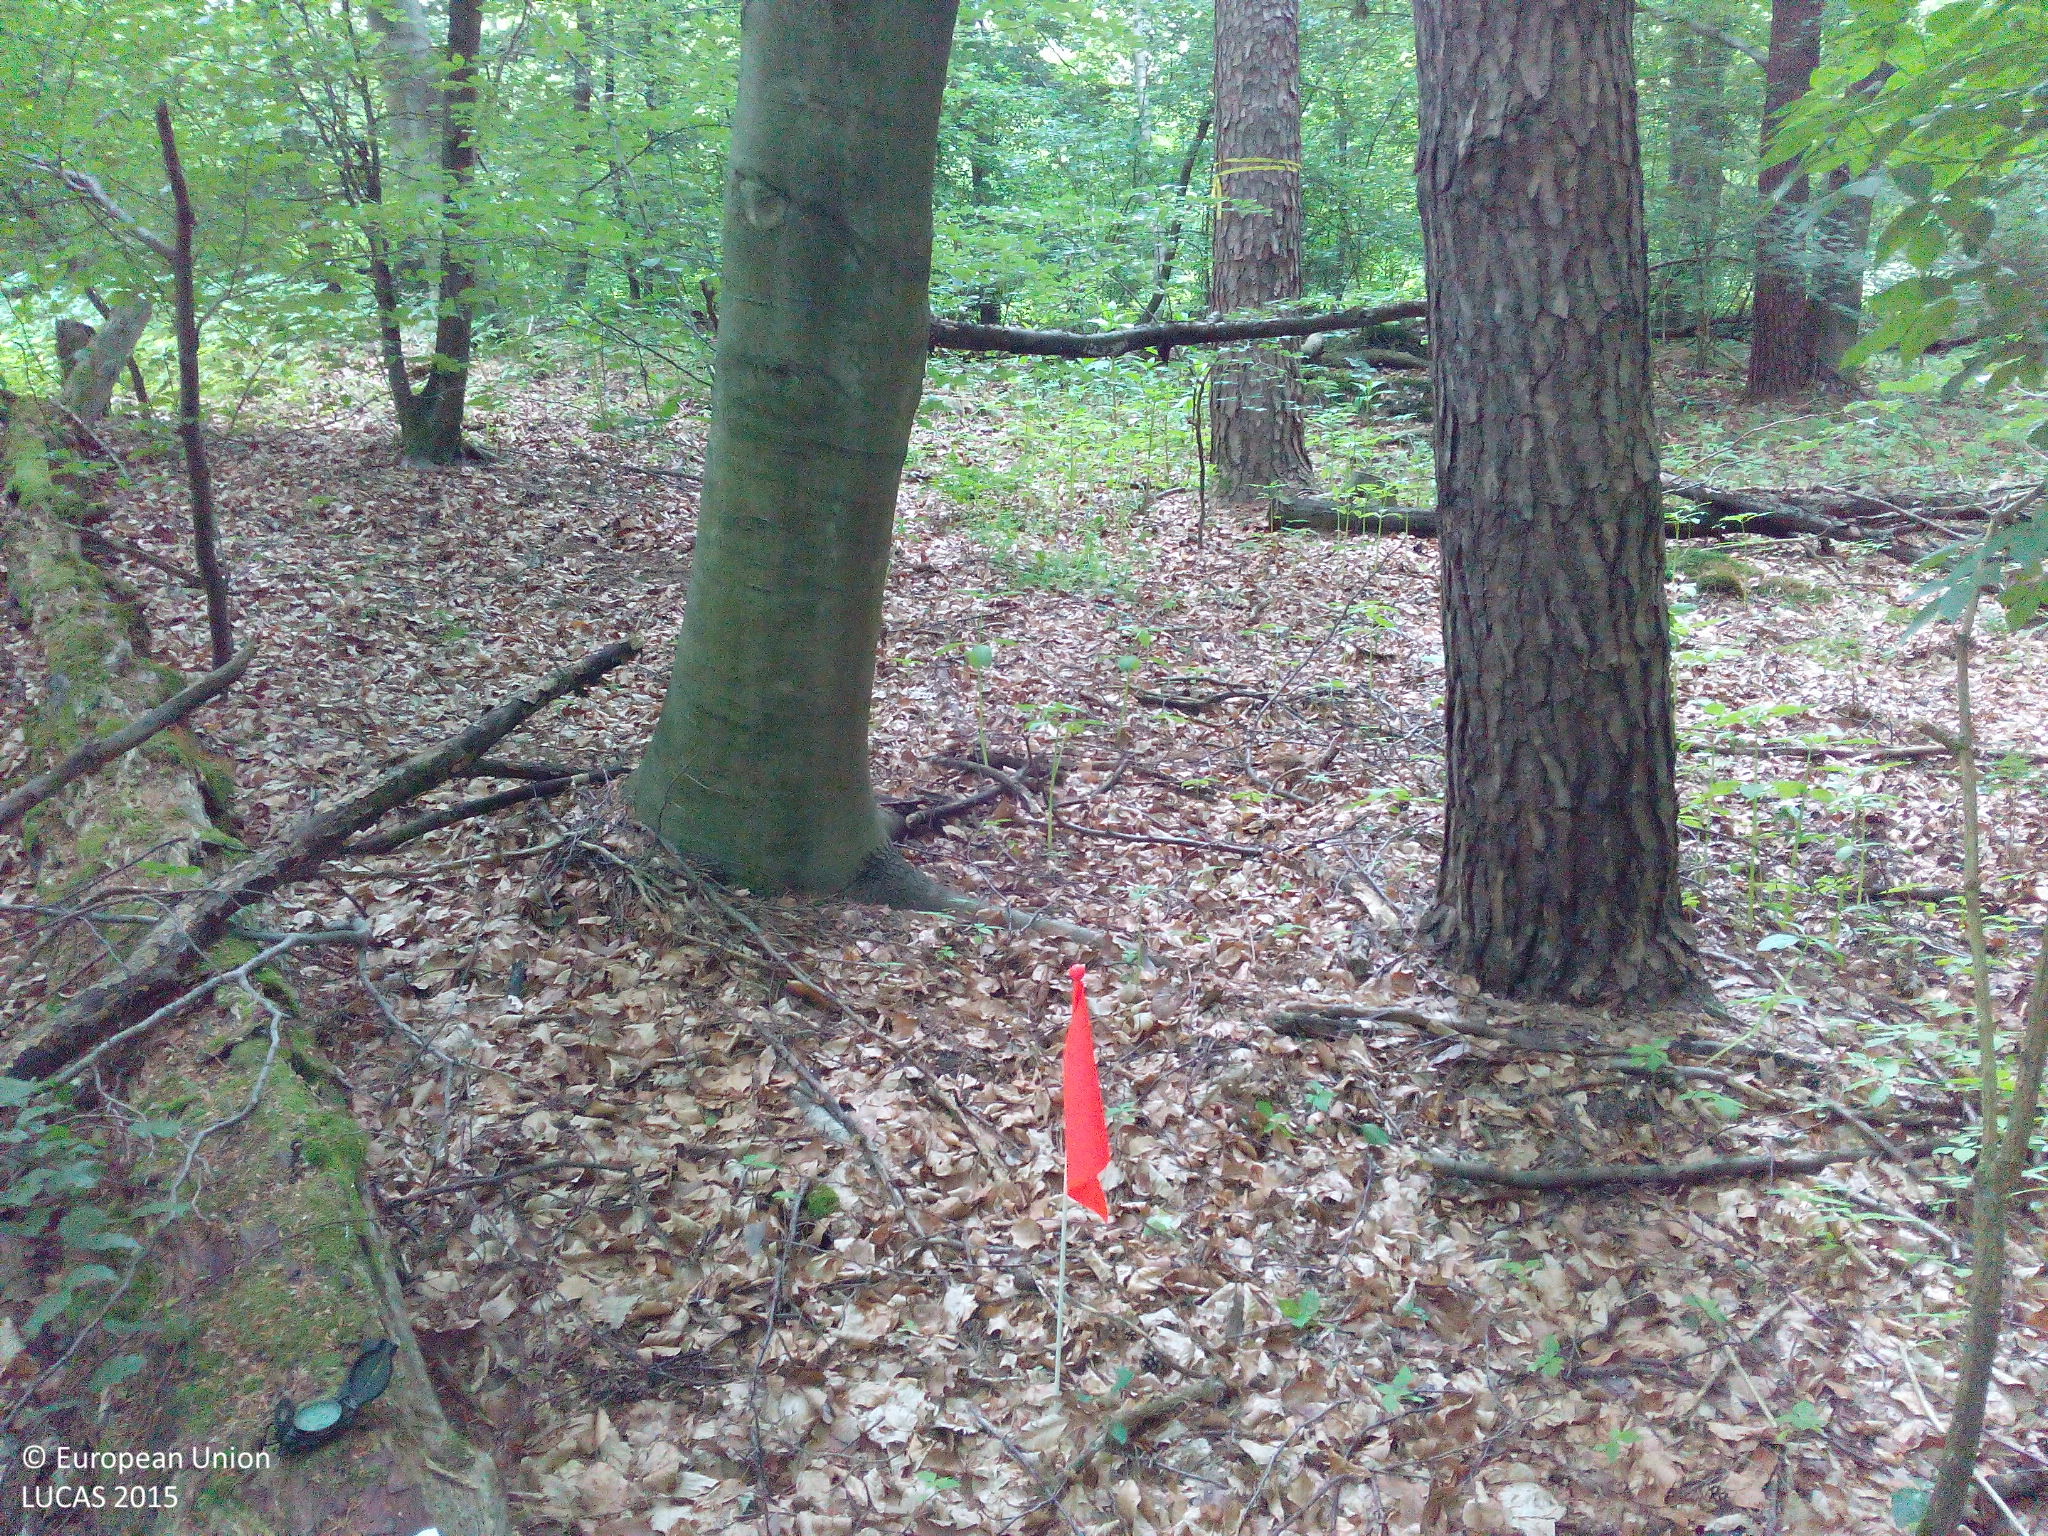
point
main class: Woodland
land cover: Broadleaved woodland
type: beech forest
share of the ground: > 75 %
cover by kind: broadleaved forest trees 85 %, coniferous forest trees 5 %, herbaceous plants 5 %, unconsolidated bare surface 5 %
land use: Forestry
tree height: > 5 m
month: May
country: DE
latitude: 48.7837
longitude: 8.1361
